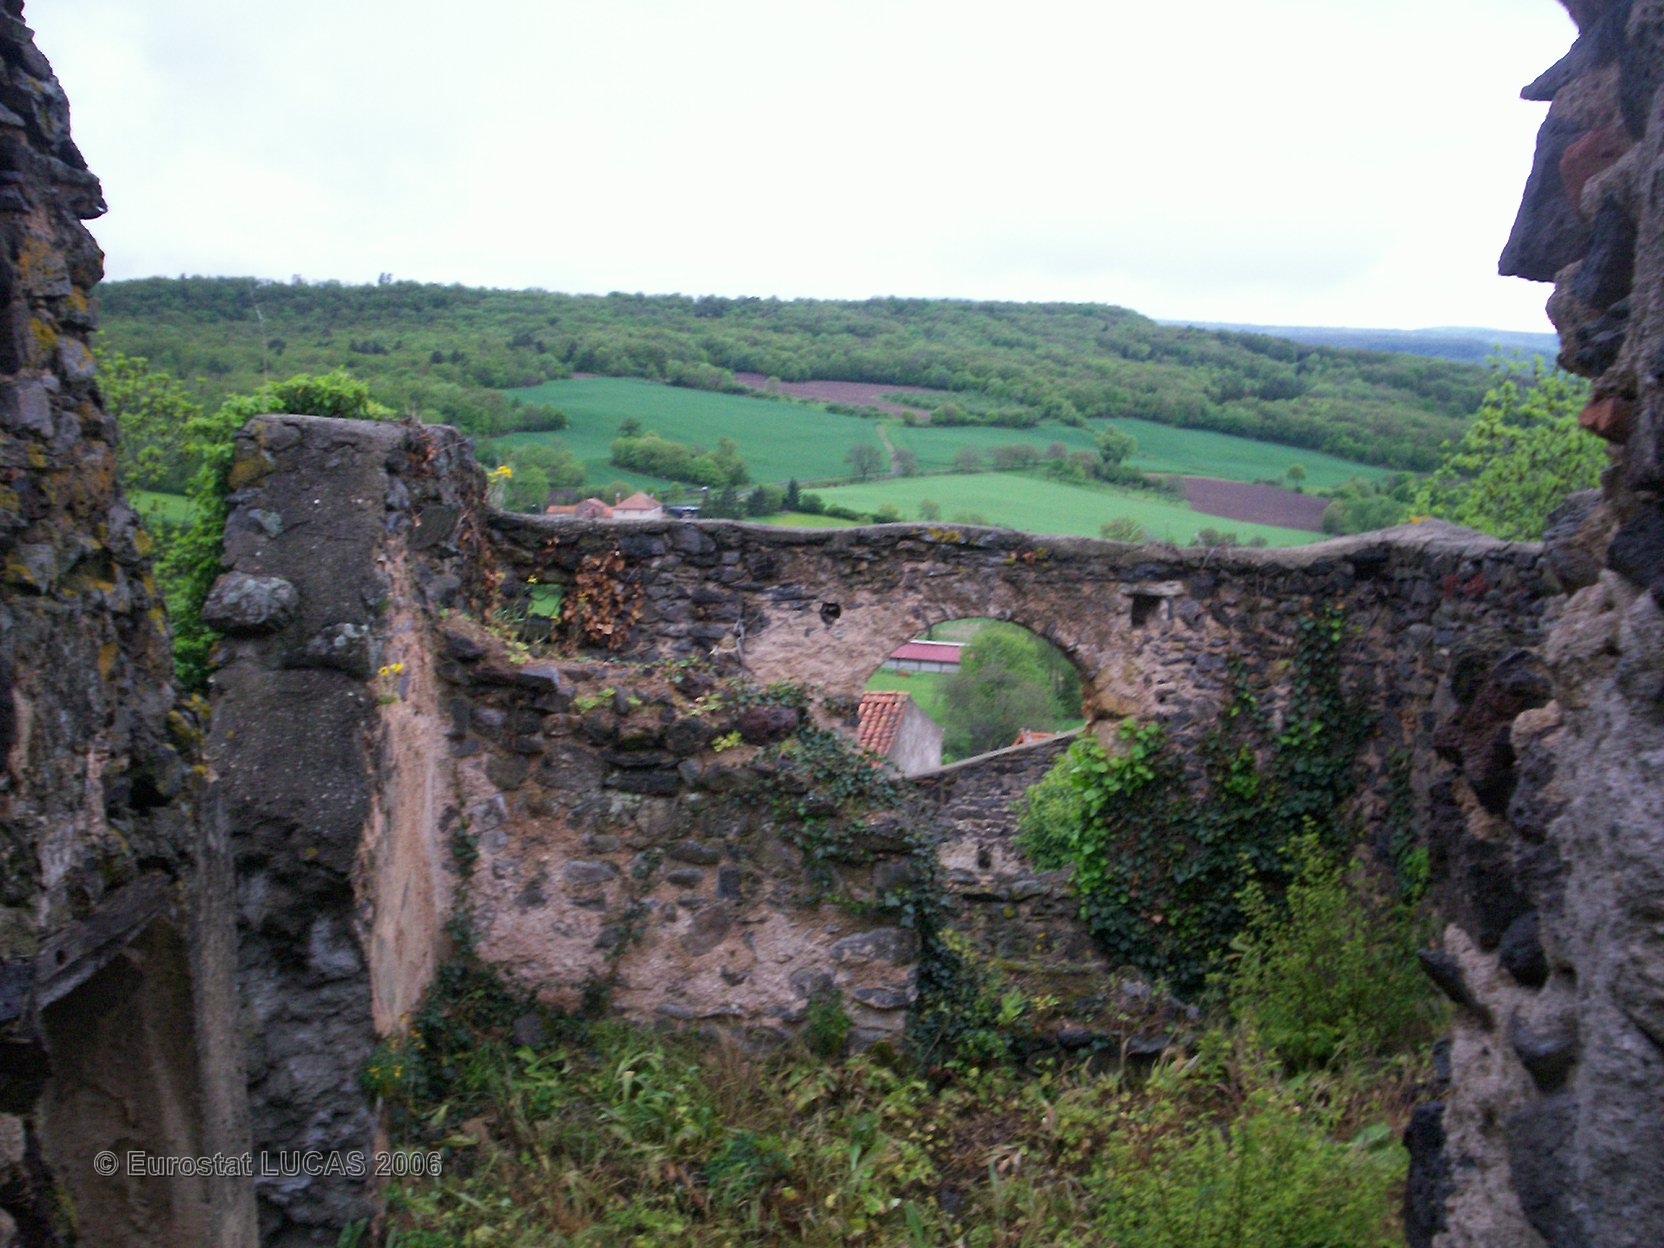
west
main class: Grassland
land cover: Grassland without tree/shrub cover
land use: Unused
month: May
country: FR
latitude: 45.4665
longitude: 3.2096
